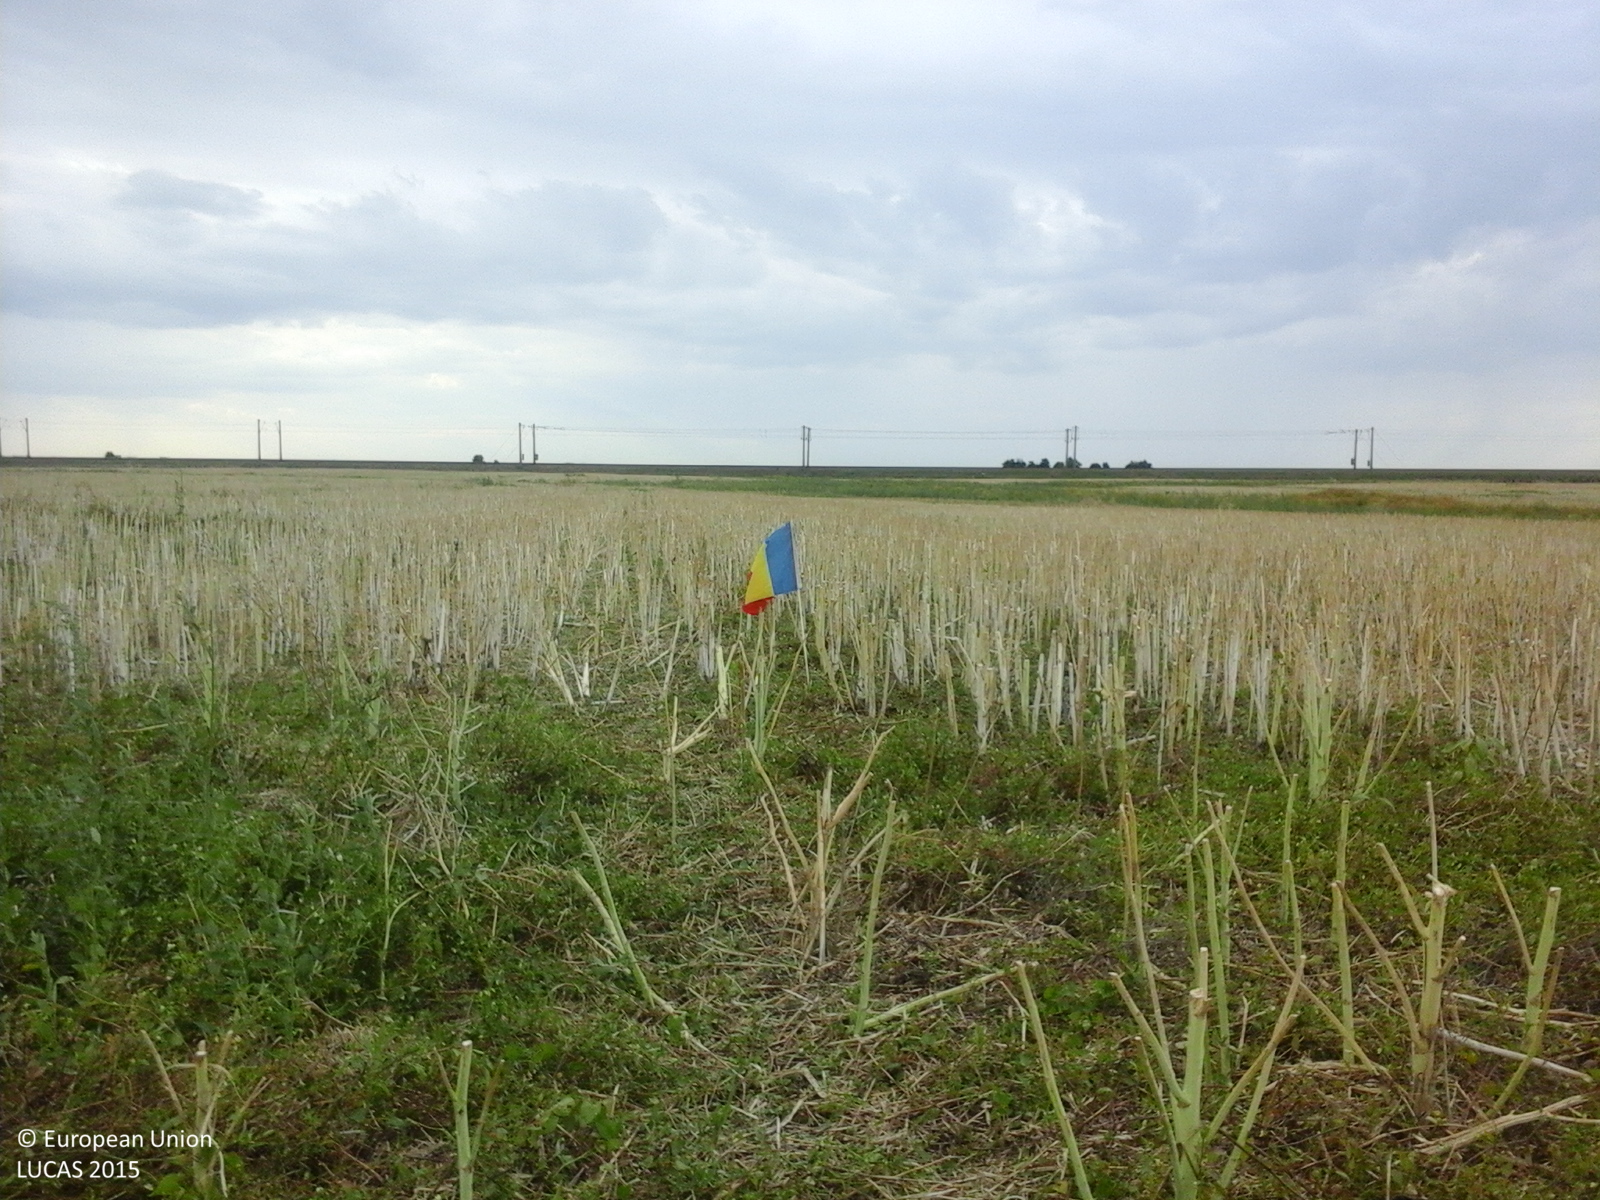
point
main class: Cropland
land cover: Rape and turnip rape
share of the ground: < 10 %
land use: Agriculture (excluding fallow land and kitchen gardens)
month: July
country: RO
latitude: 44.1201
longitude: 24.8320
